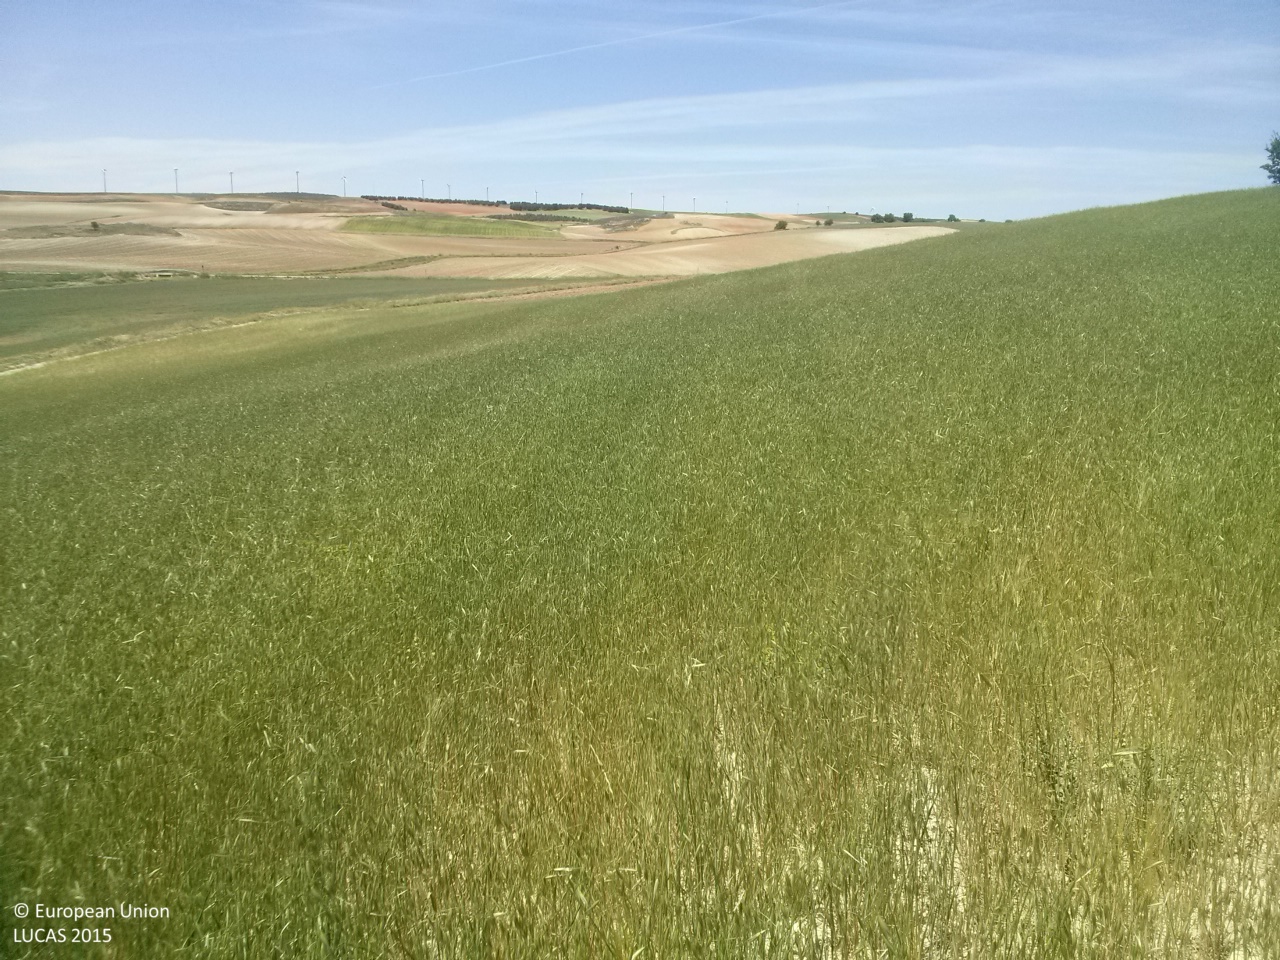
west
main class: Cropland
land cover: Mixed cereals for fodder
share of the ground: > 75 %
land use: Agriculture (excluding fallow land and kitchen gardens)
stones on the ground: < 10 %
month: May
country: ES
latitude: 39.9867
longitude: -2.7033
